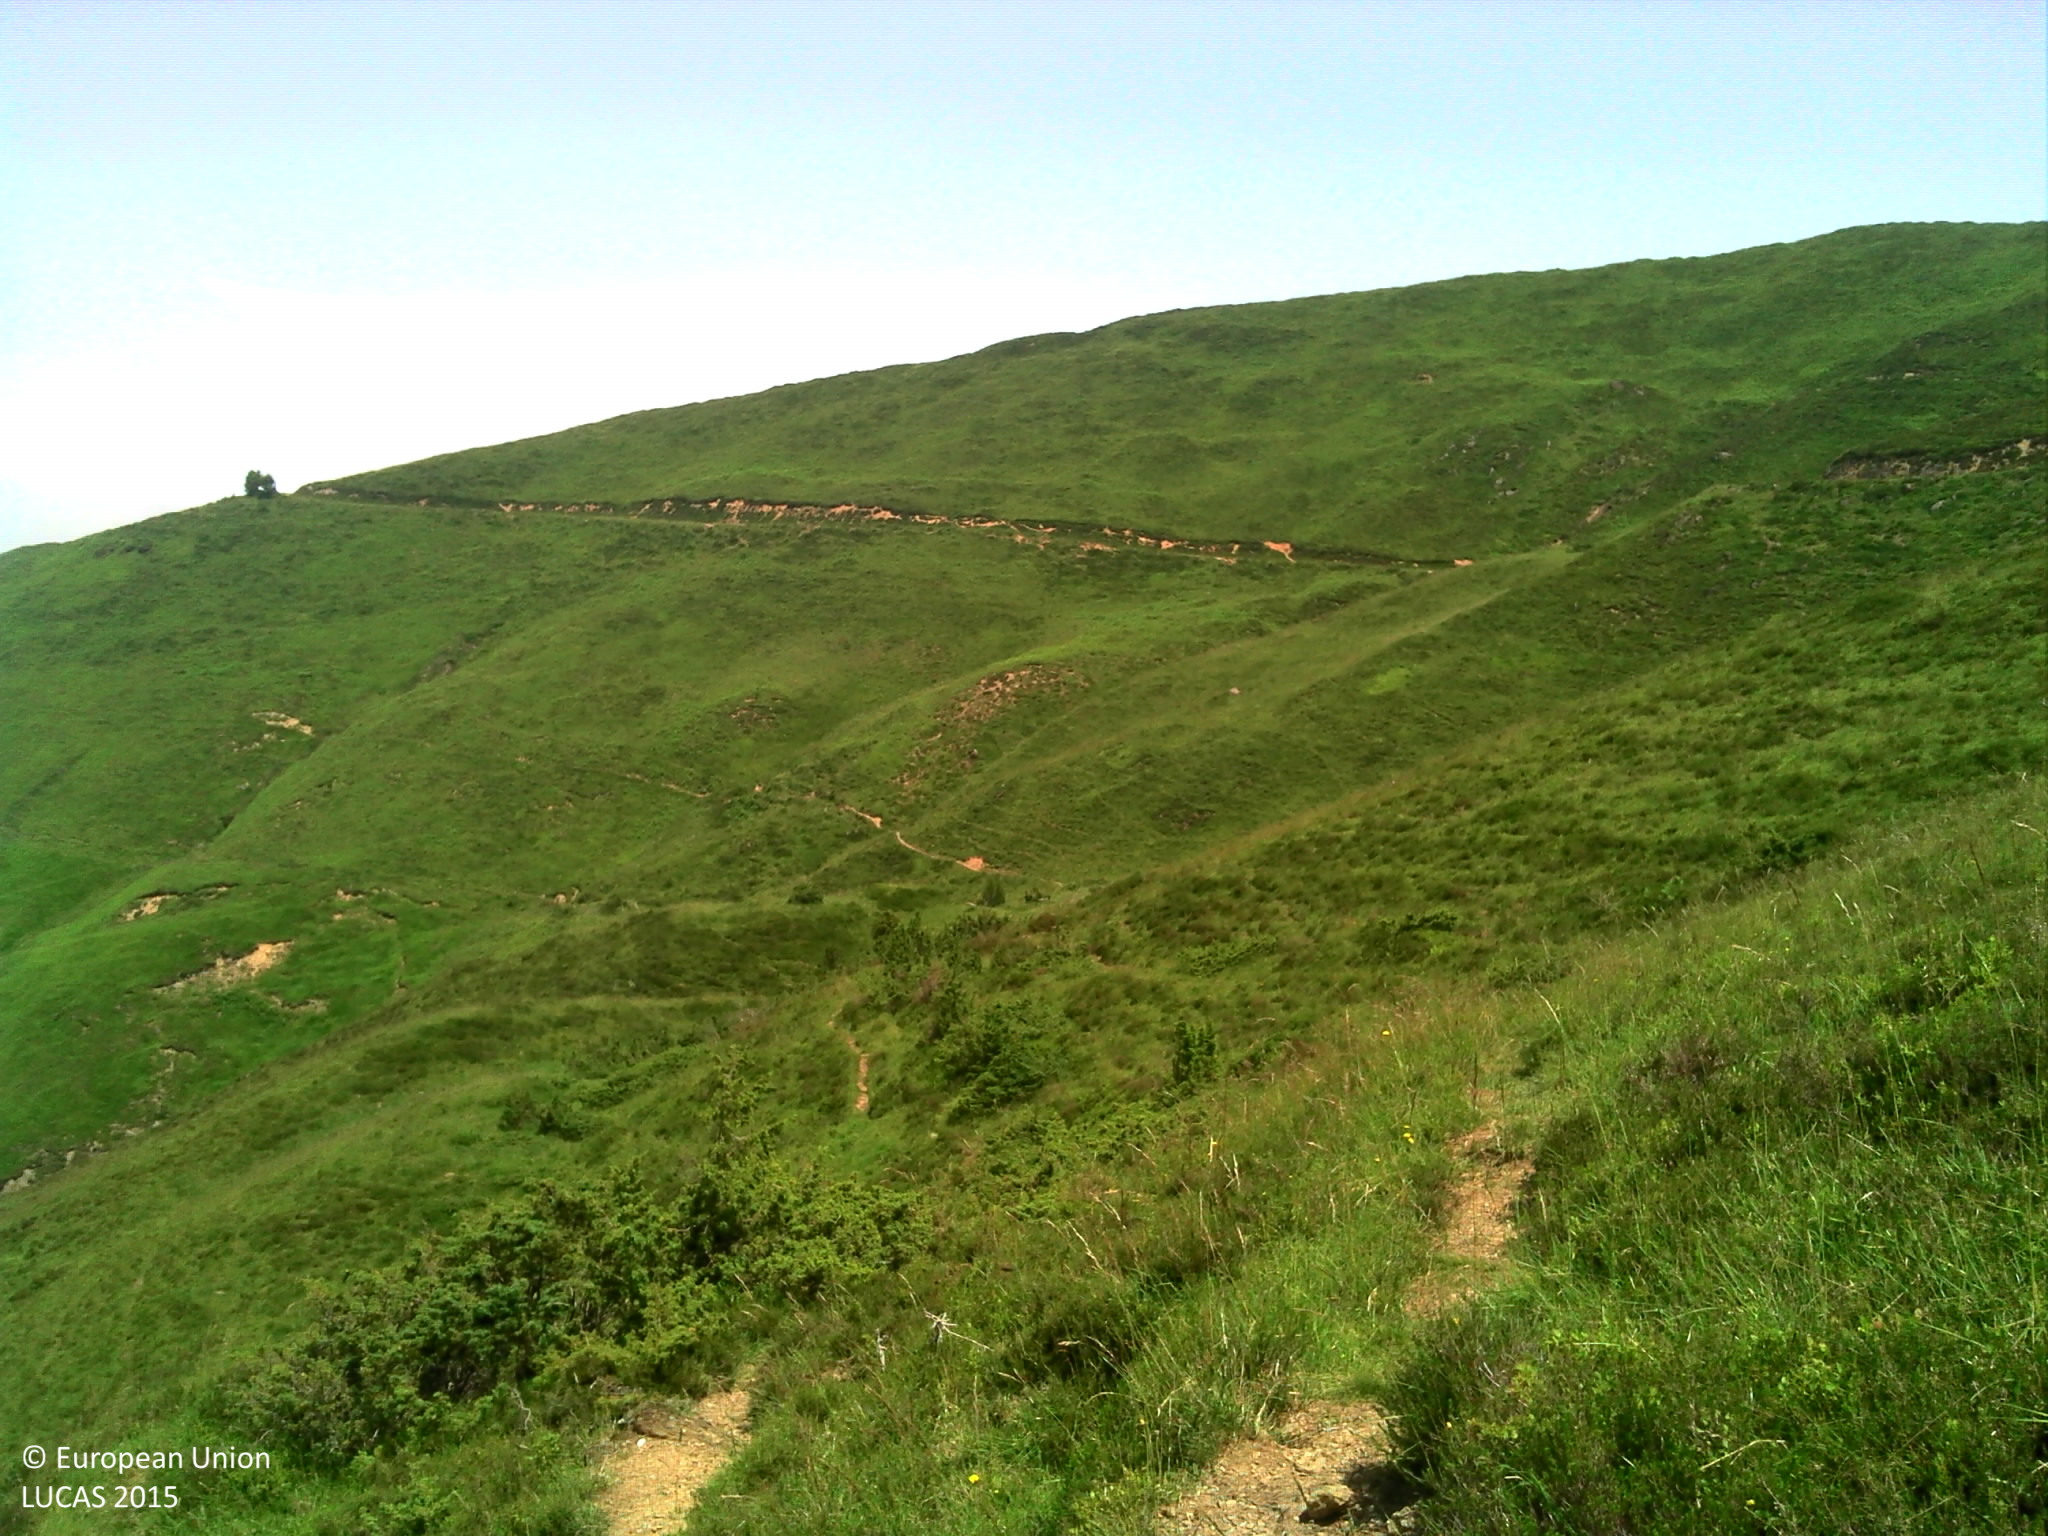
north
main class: Shrubland
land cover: Shrubland without tree cover
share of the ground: > 75 %
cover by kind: shrubs 60 %, herbaceous plants 40 %
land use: Agriculture (excluding fallow land and kitchen gardens)
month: July
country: FR
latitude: 42.9677
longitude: -0.2655
